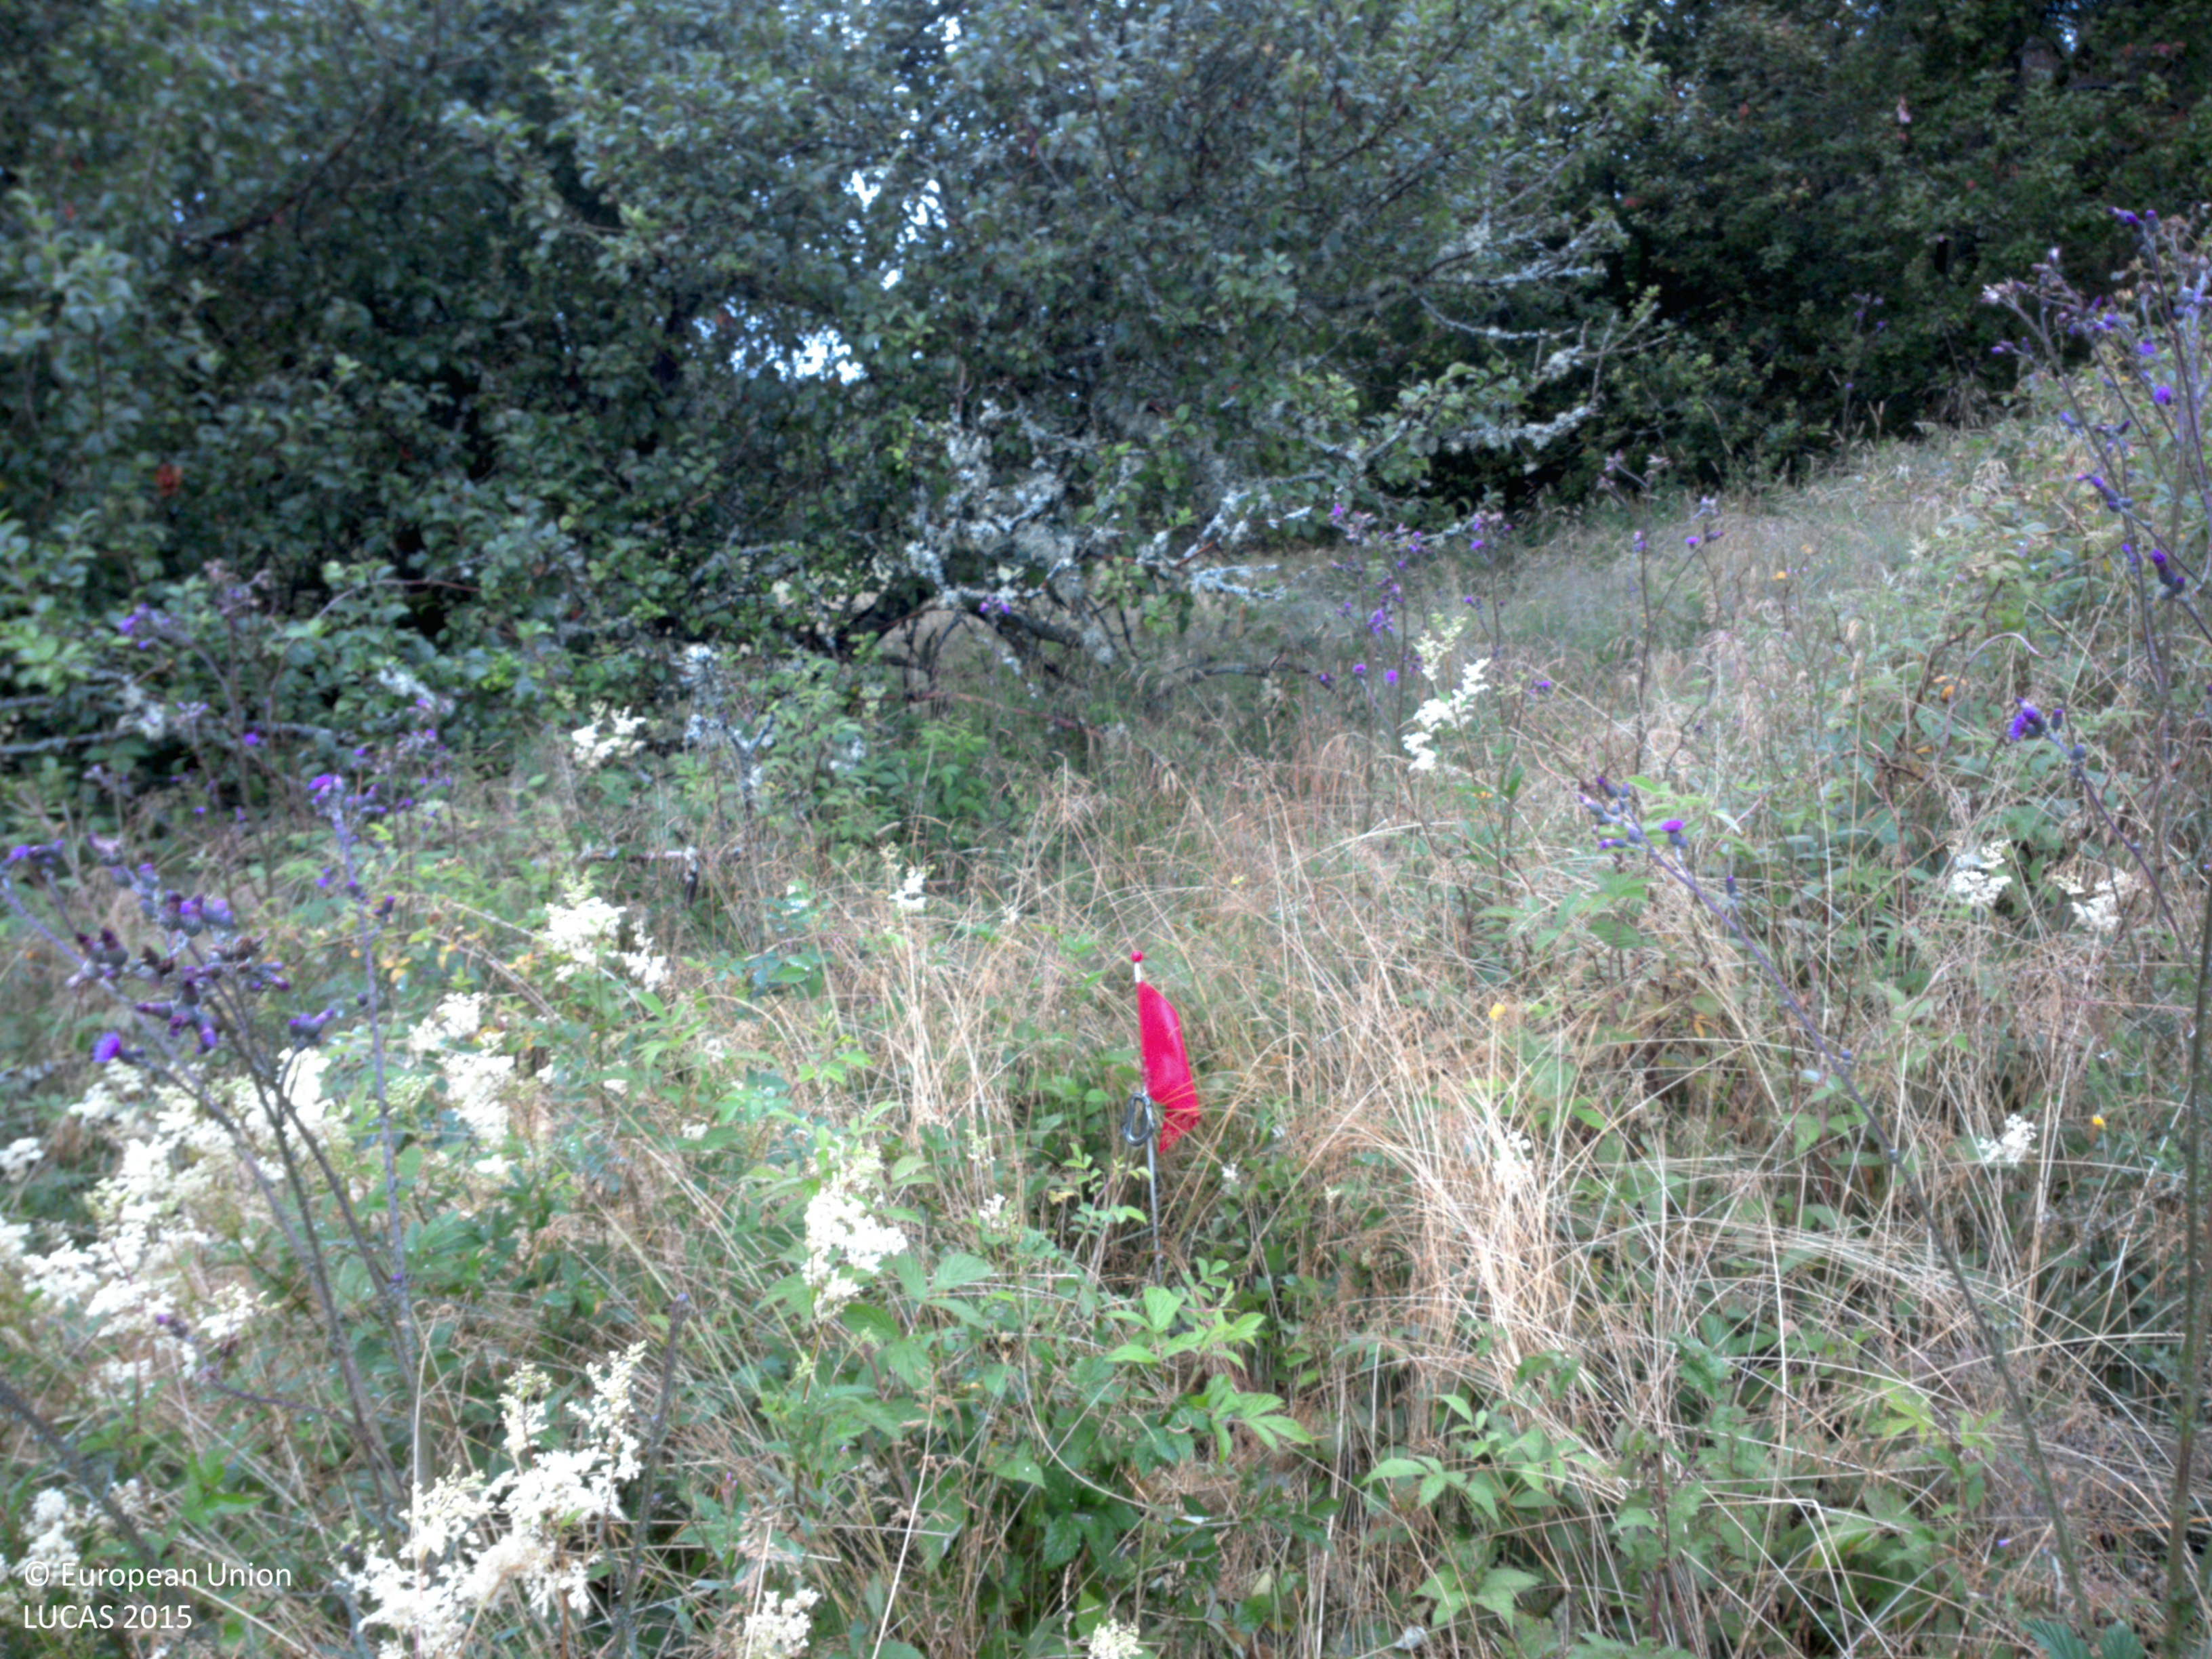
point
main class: Shrubland
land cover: Shrubland with sparse tree cover
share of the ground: > 75 %
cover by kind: herbaceous plants 80 %, shrubs 15 %, broadleaved forest trees 5 %
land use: Agriculture (excluding fallow land and kitchen gardens)
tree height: < 5 m
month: July
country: SE
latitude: 58.7281
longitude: 11.8784
